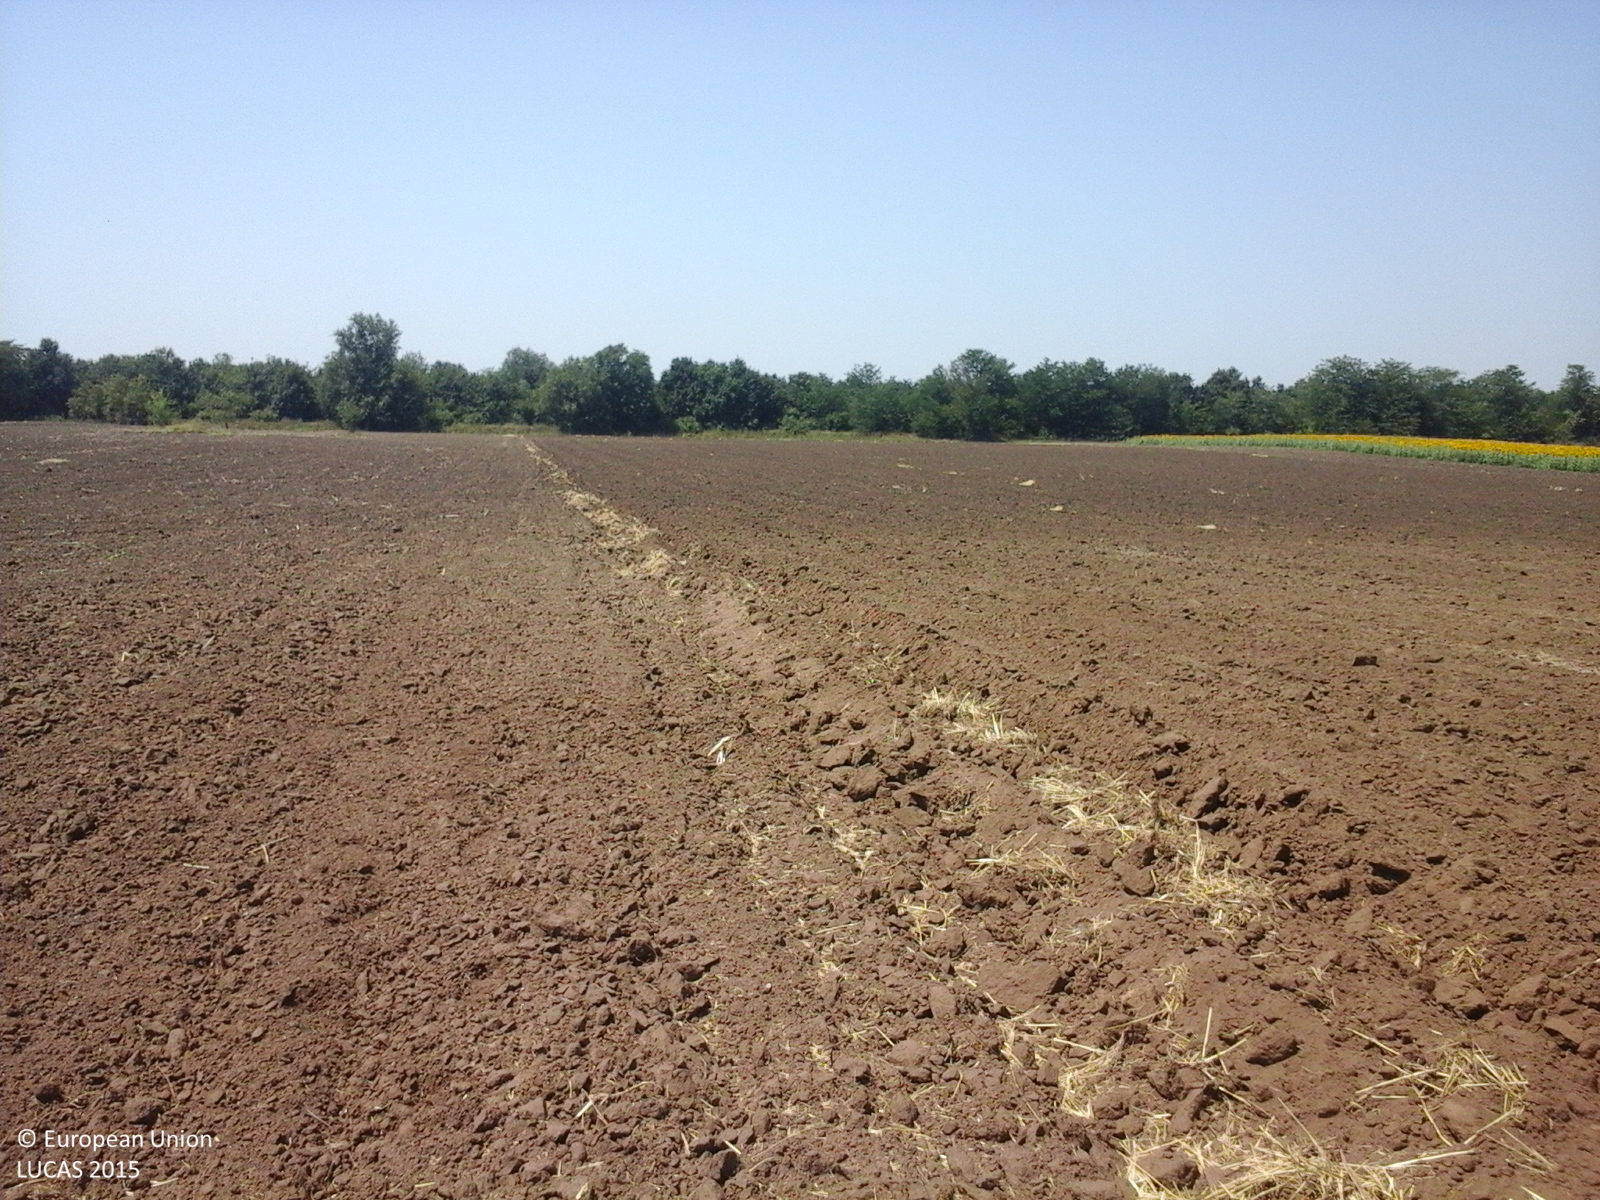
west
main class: Cropland
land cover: Rape and turnip rape
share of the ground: < 10 %
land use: Agriculture (excluding fallow land and kitchen gardens)
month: July
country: RO
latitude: 44.5446
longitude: 27.6040
